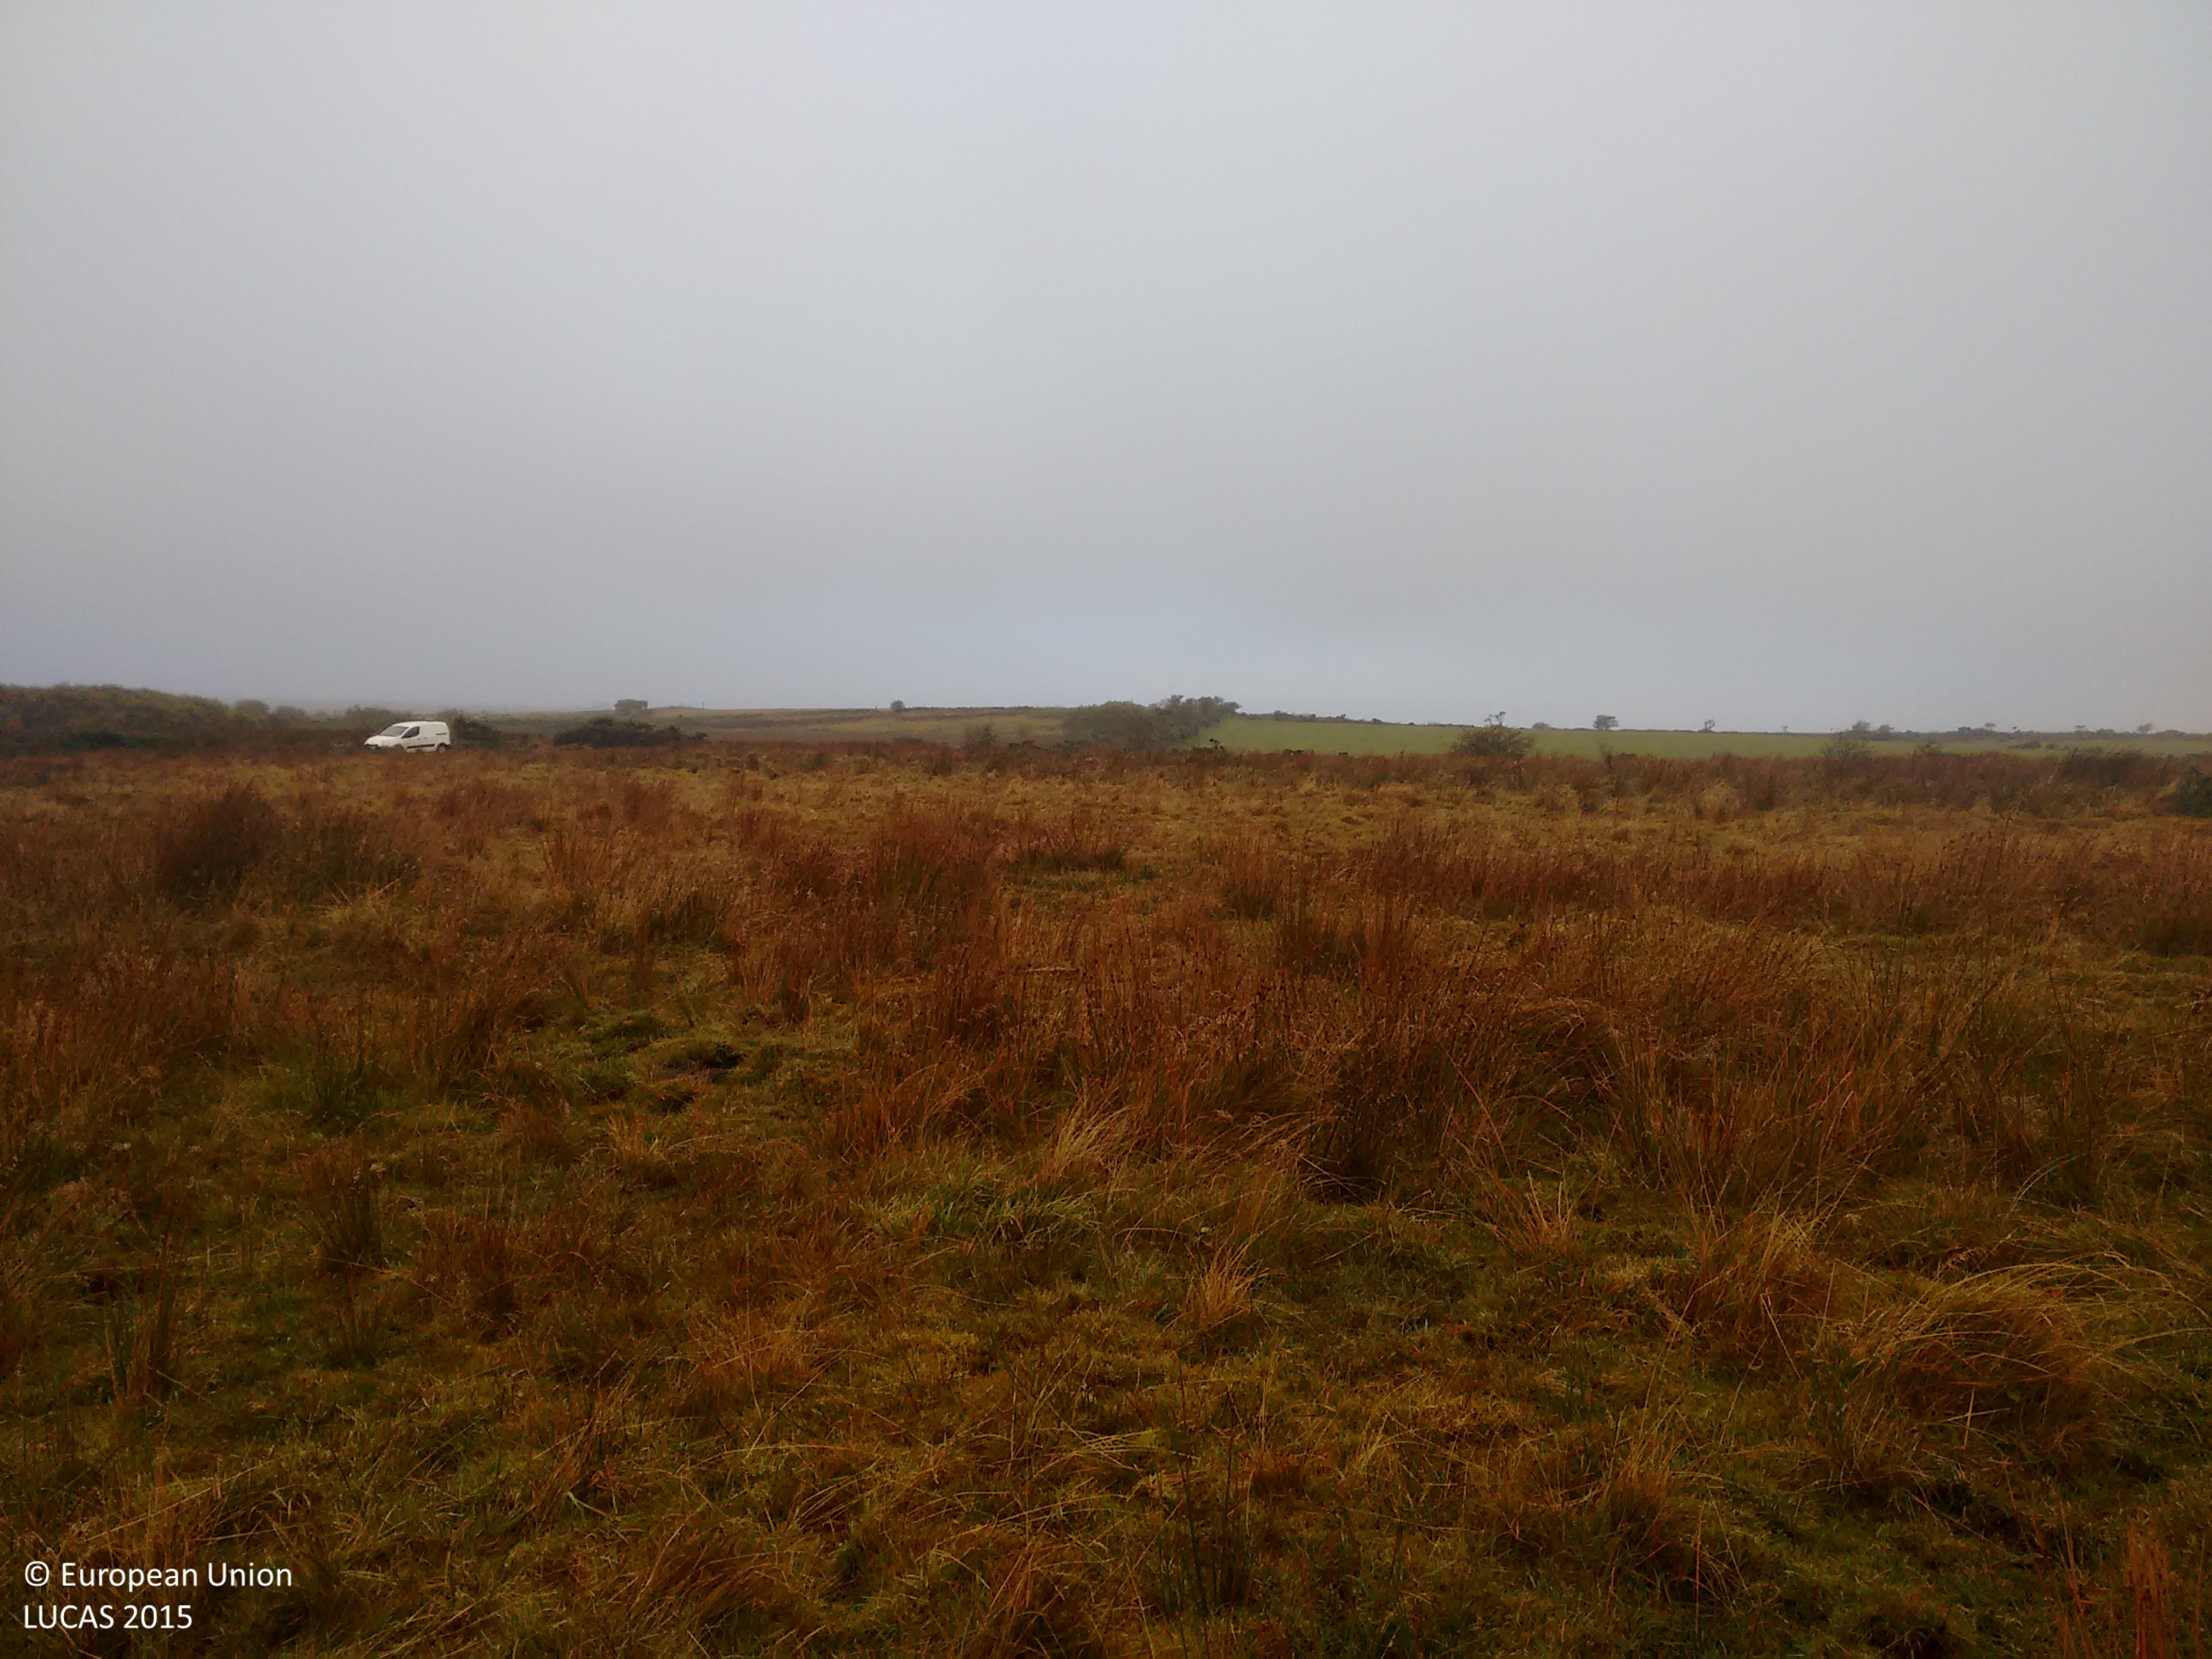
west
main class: Grassland
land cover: Grassland without tree/shrub cover
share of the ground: > 75 %
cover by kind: herbaceous plants 80 %, lichens and mosses 20 %
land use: Agriculture (excluding fallow land and kitchen gardens)
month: October
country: GB
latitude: 55.7441
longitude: -6.2814
